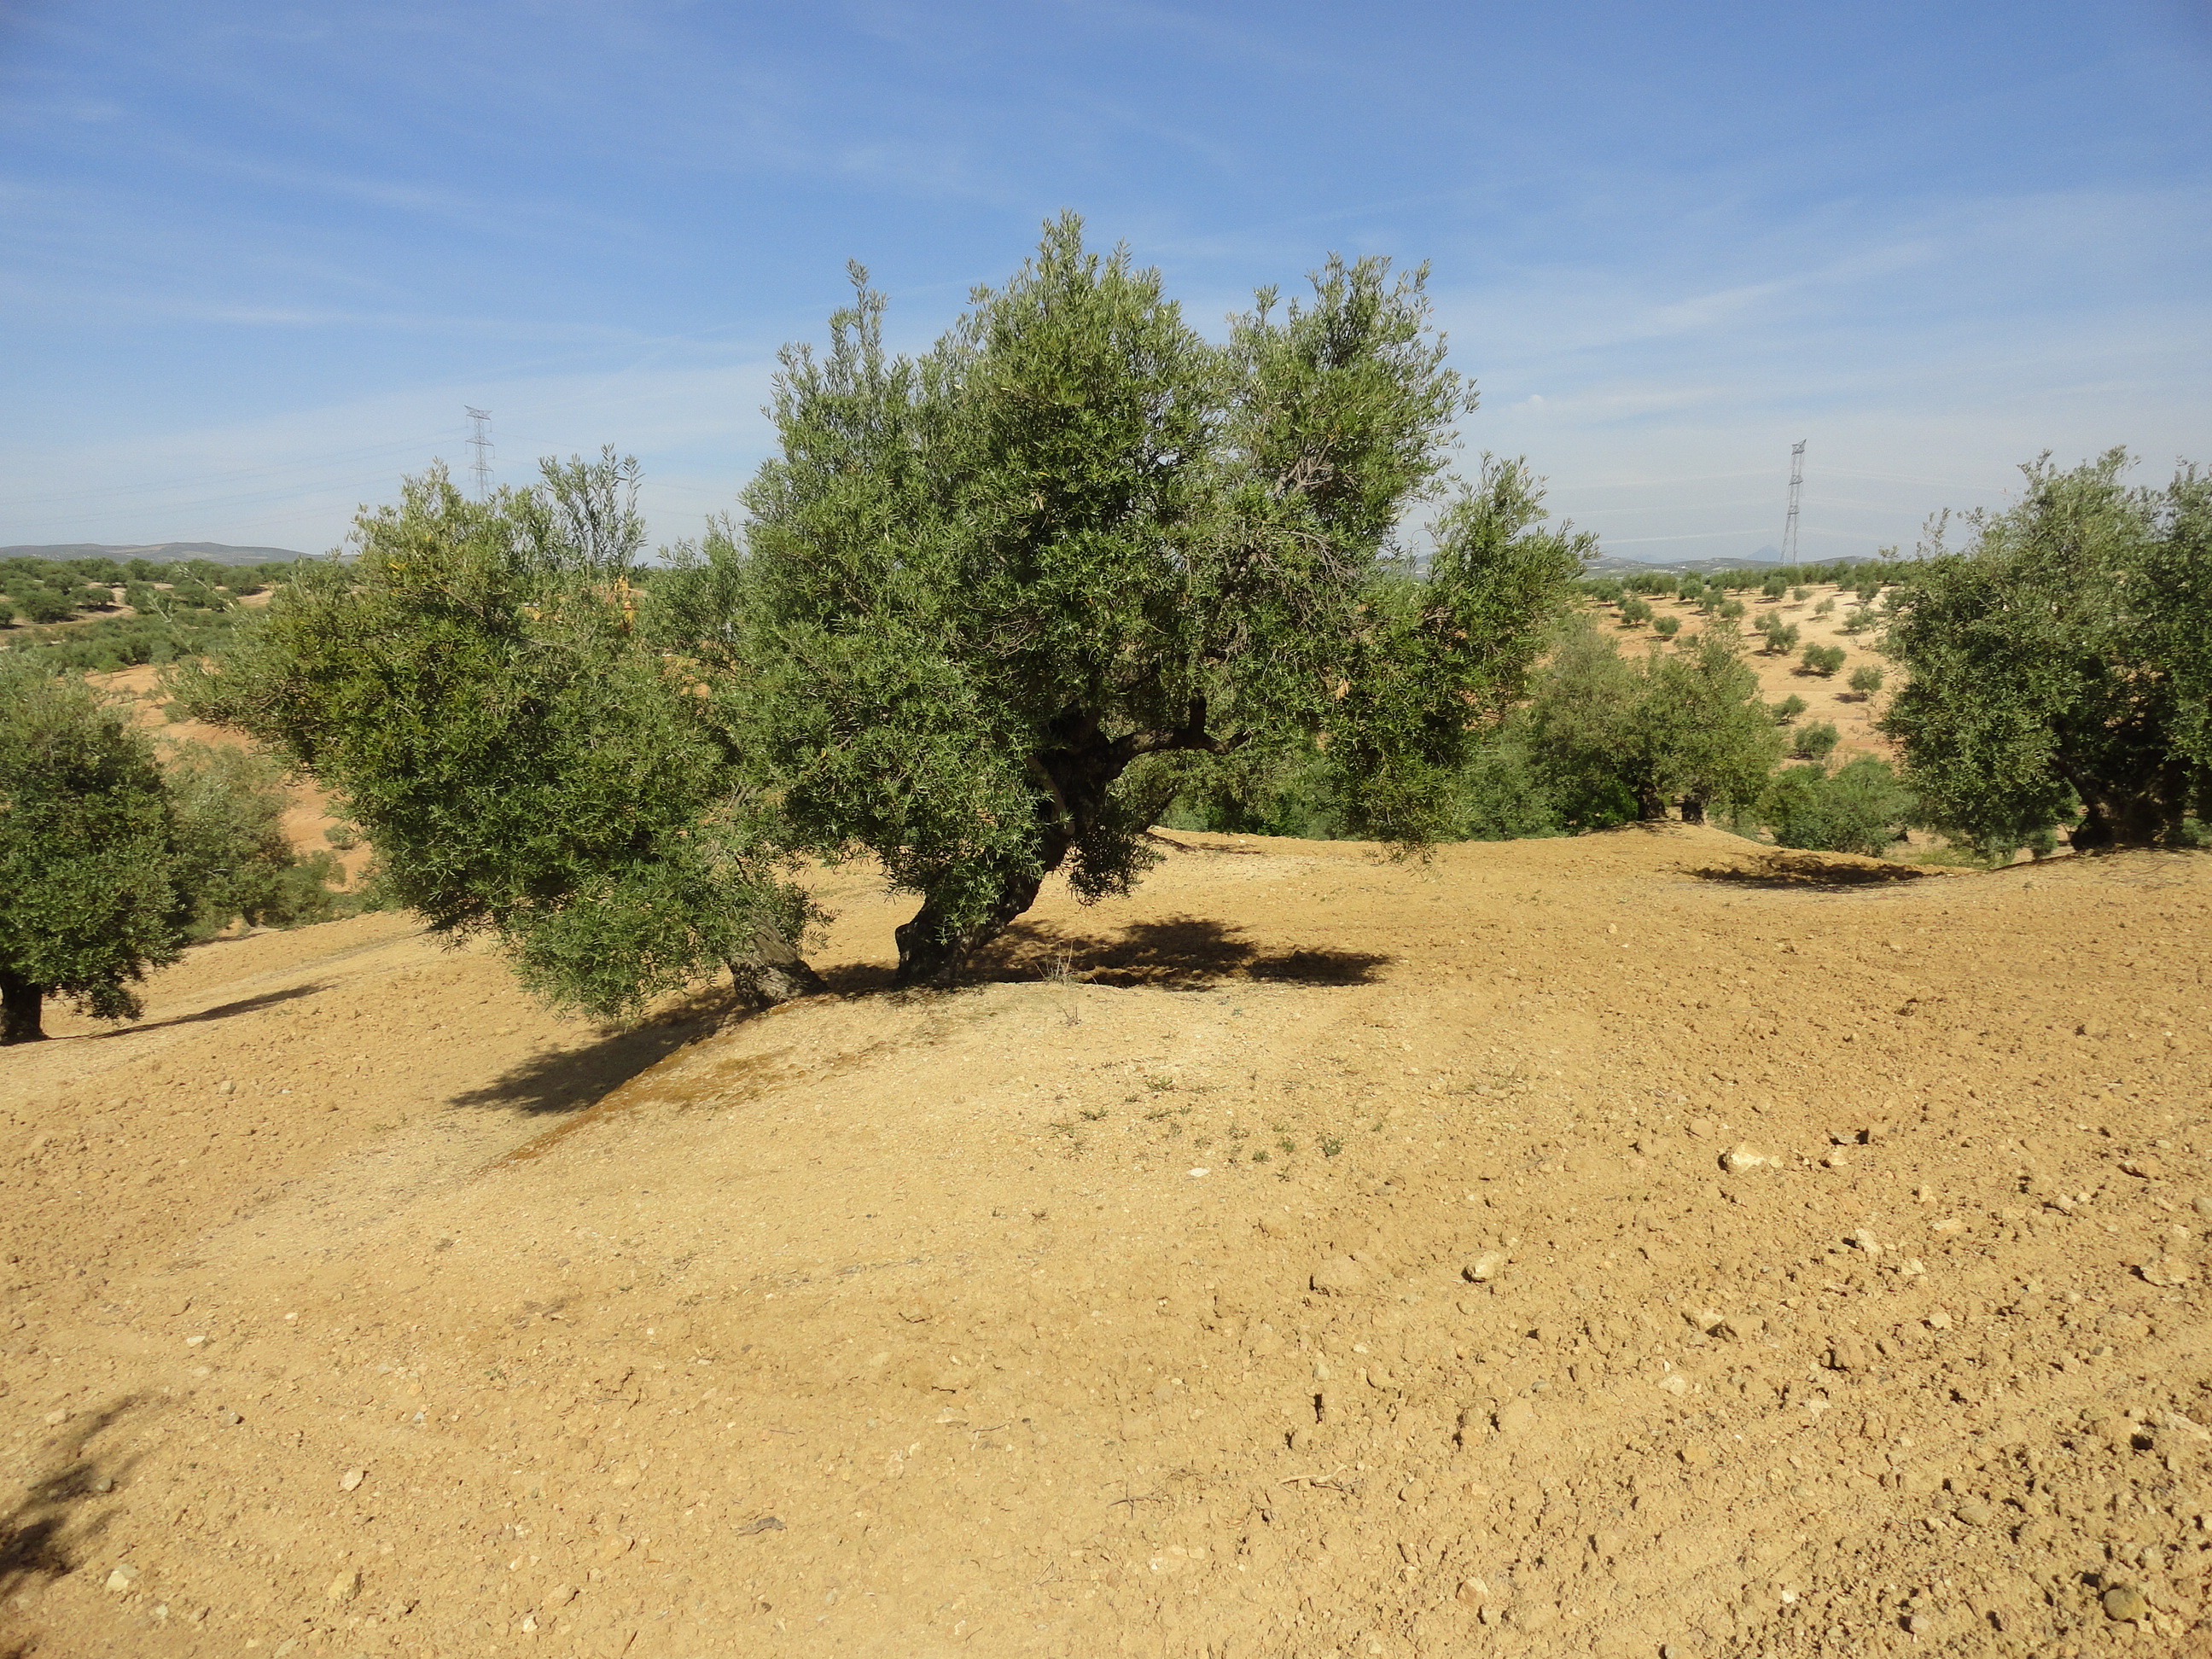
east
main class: Cropland
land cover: Olive groves
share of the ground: 25 - 50 %
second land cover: Other bare soil
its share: > 75 %
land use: Agriculture (excluding fallow land and kitchen gardens)
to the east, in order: Olive groves; Other bare soil; Grass margins; Other structural elements; Single bushes/trees; Olive groves; Electric lines; Olive groves; Grass margins; Paved roads, cycling and walking lanes
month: April
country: ES
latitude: 37.6545
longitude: -4.4125
